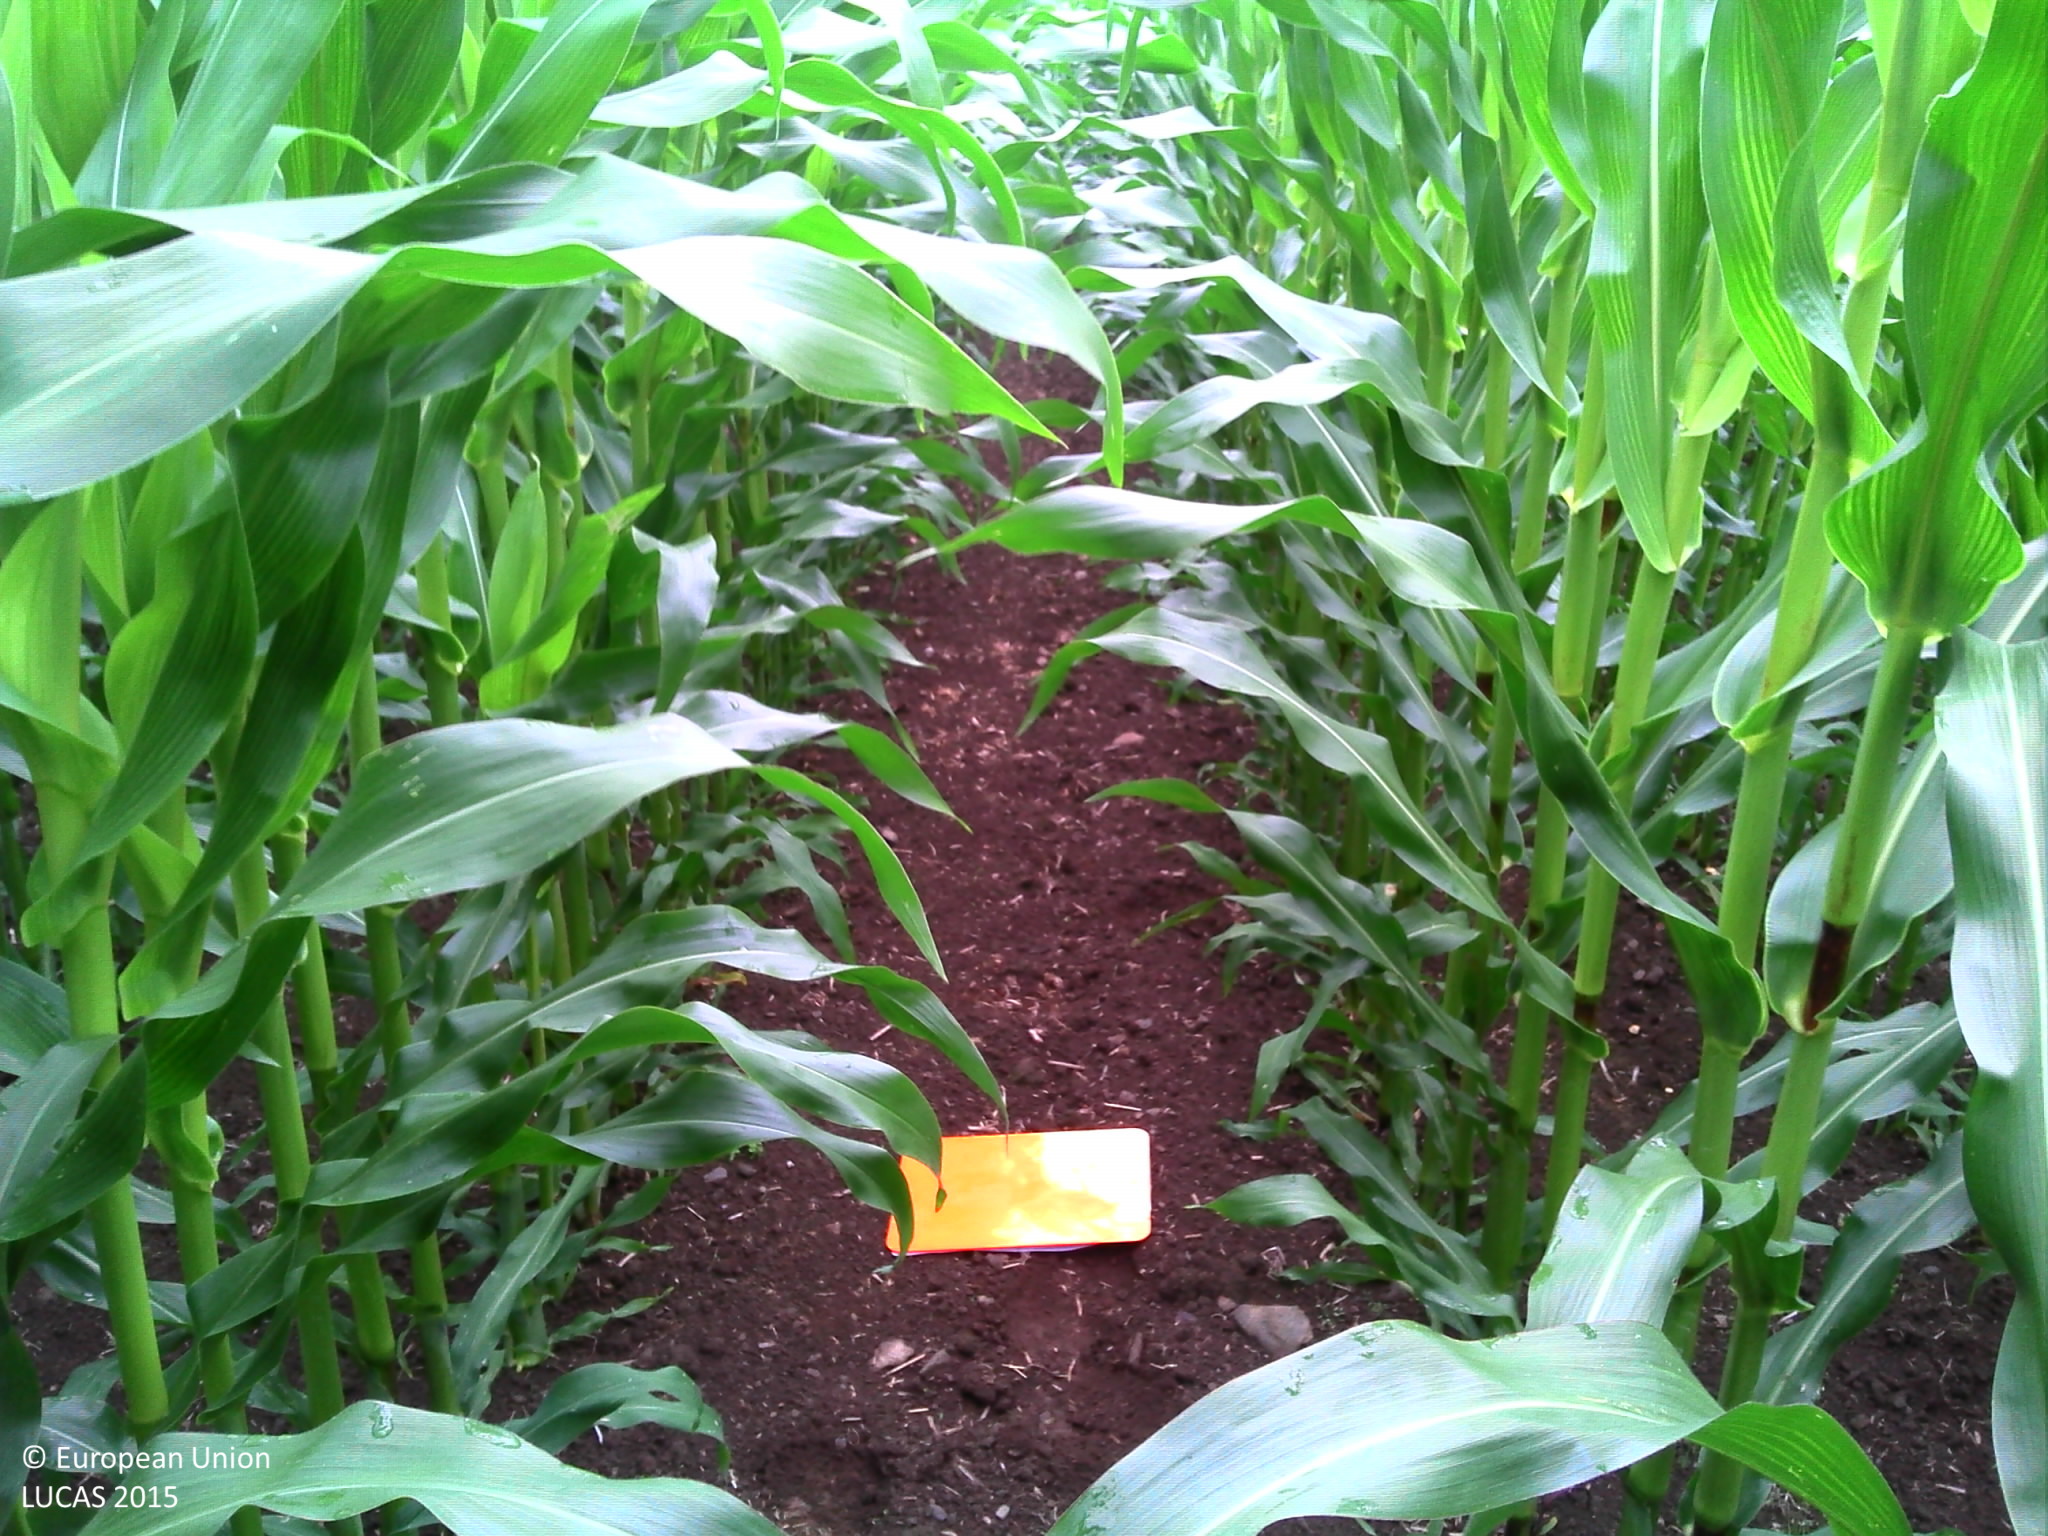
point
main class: Cropland
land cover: Maize
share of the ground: 50 - 75 %
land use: Agriculture (excluding fallow land and kitchen gardens)
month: July
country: FR
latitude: 48.2294
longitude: -3.0336
